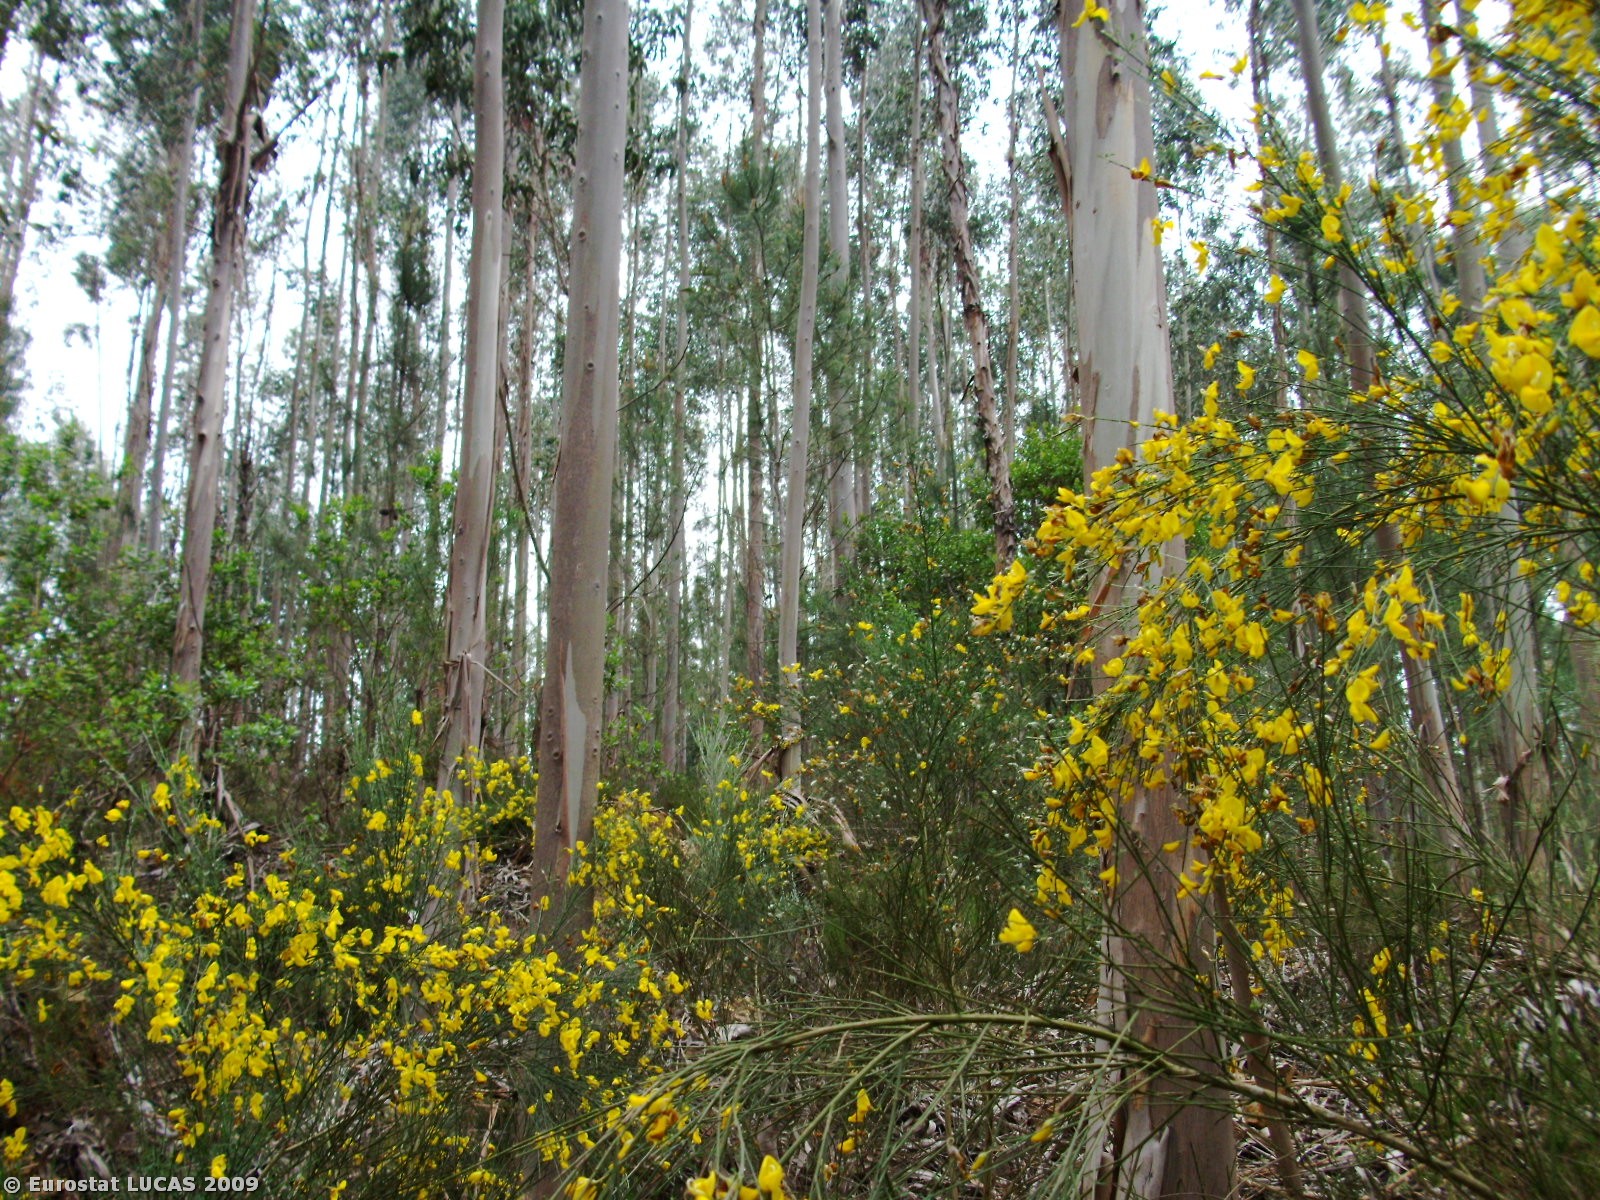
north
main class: Woodland
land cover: Broadleaved woodland
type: plantations and self-sown exotic forest
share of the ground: > 75 %
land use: Forestry
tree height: > 5 m
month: May
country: PT
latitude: 40.4259
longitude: -8.3427
